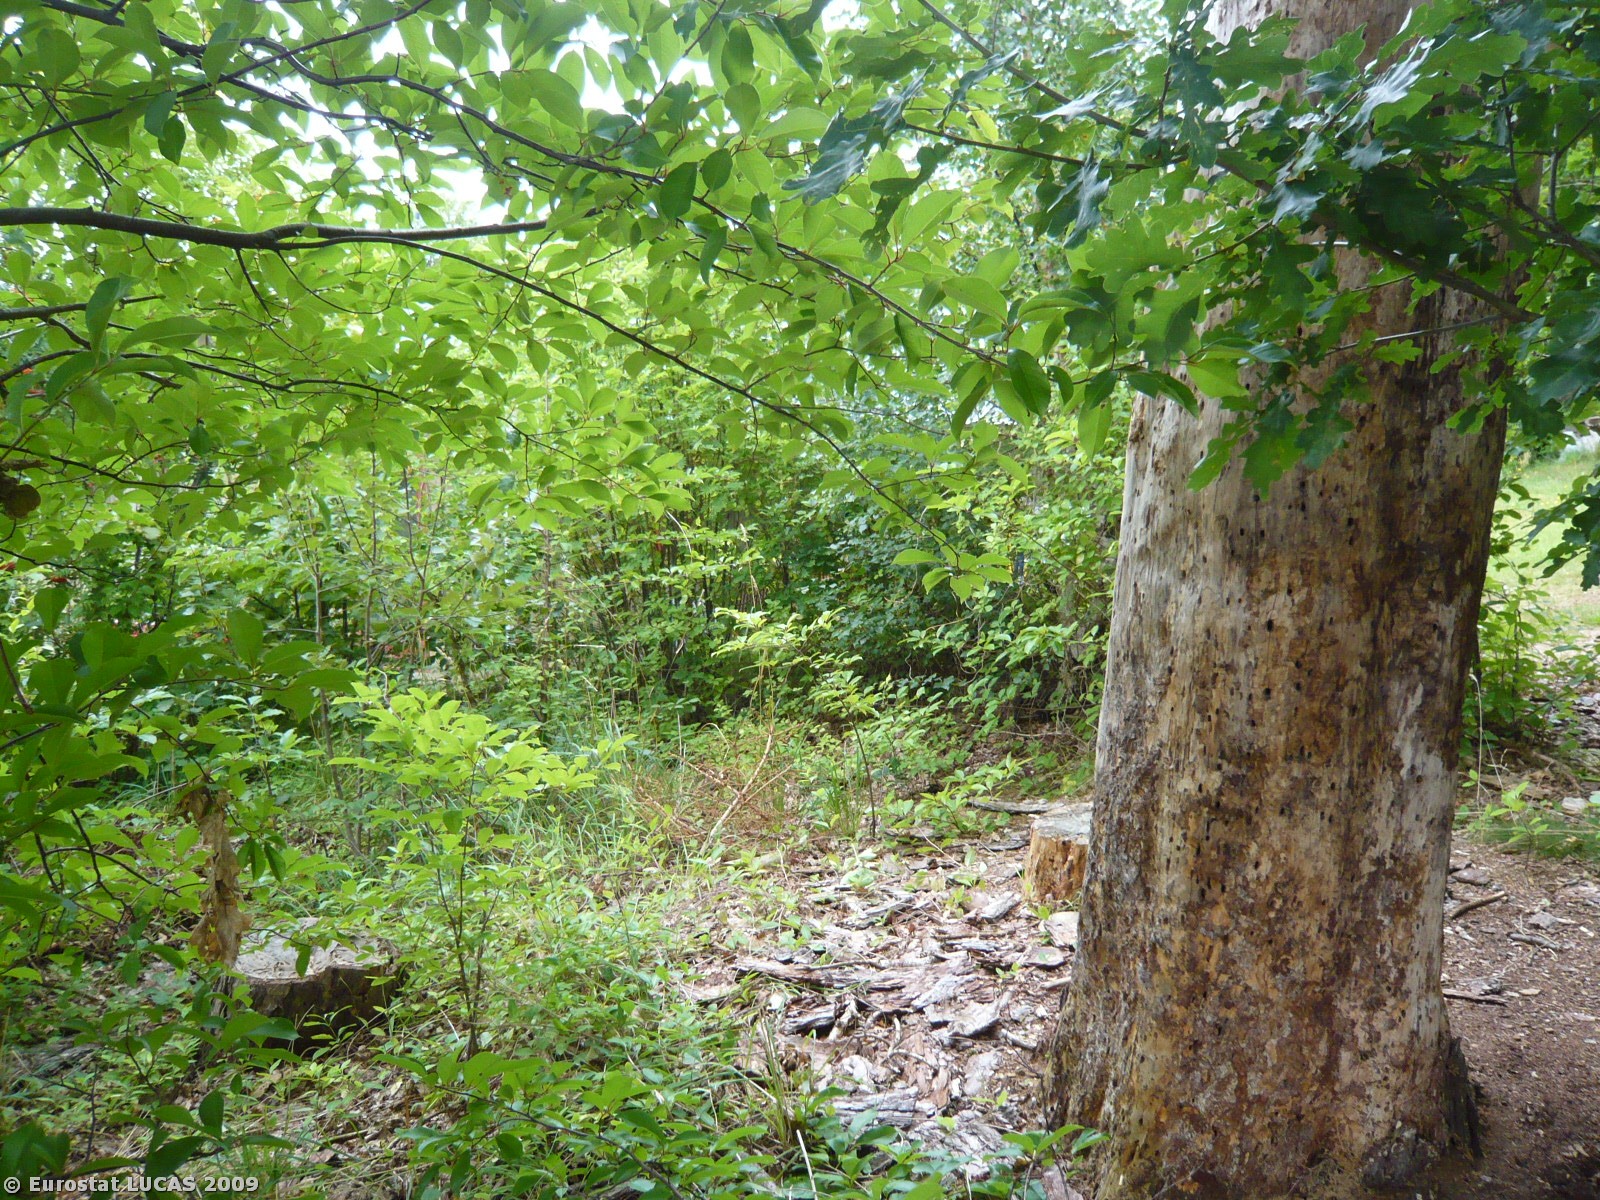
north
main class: Woodland
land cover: Broadleaved woodland
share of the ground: > 75 %
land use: Residential
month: August
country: DK
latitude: 56.0975
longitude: 12.1680
